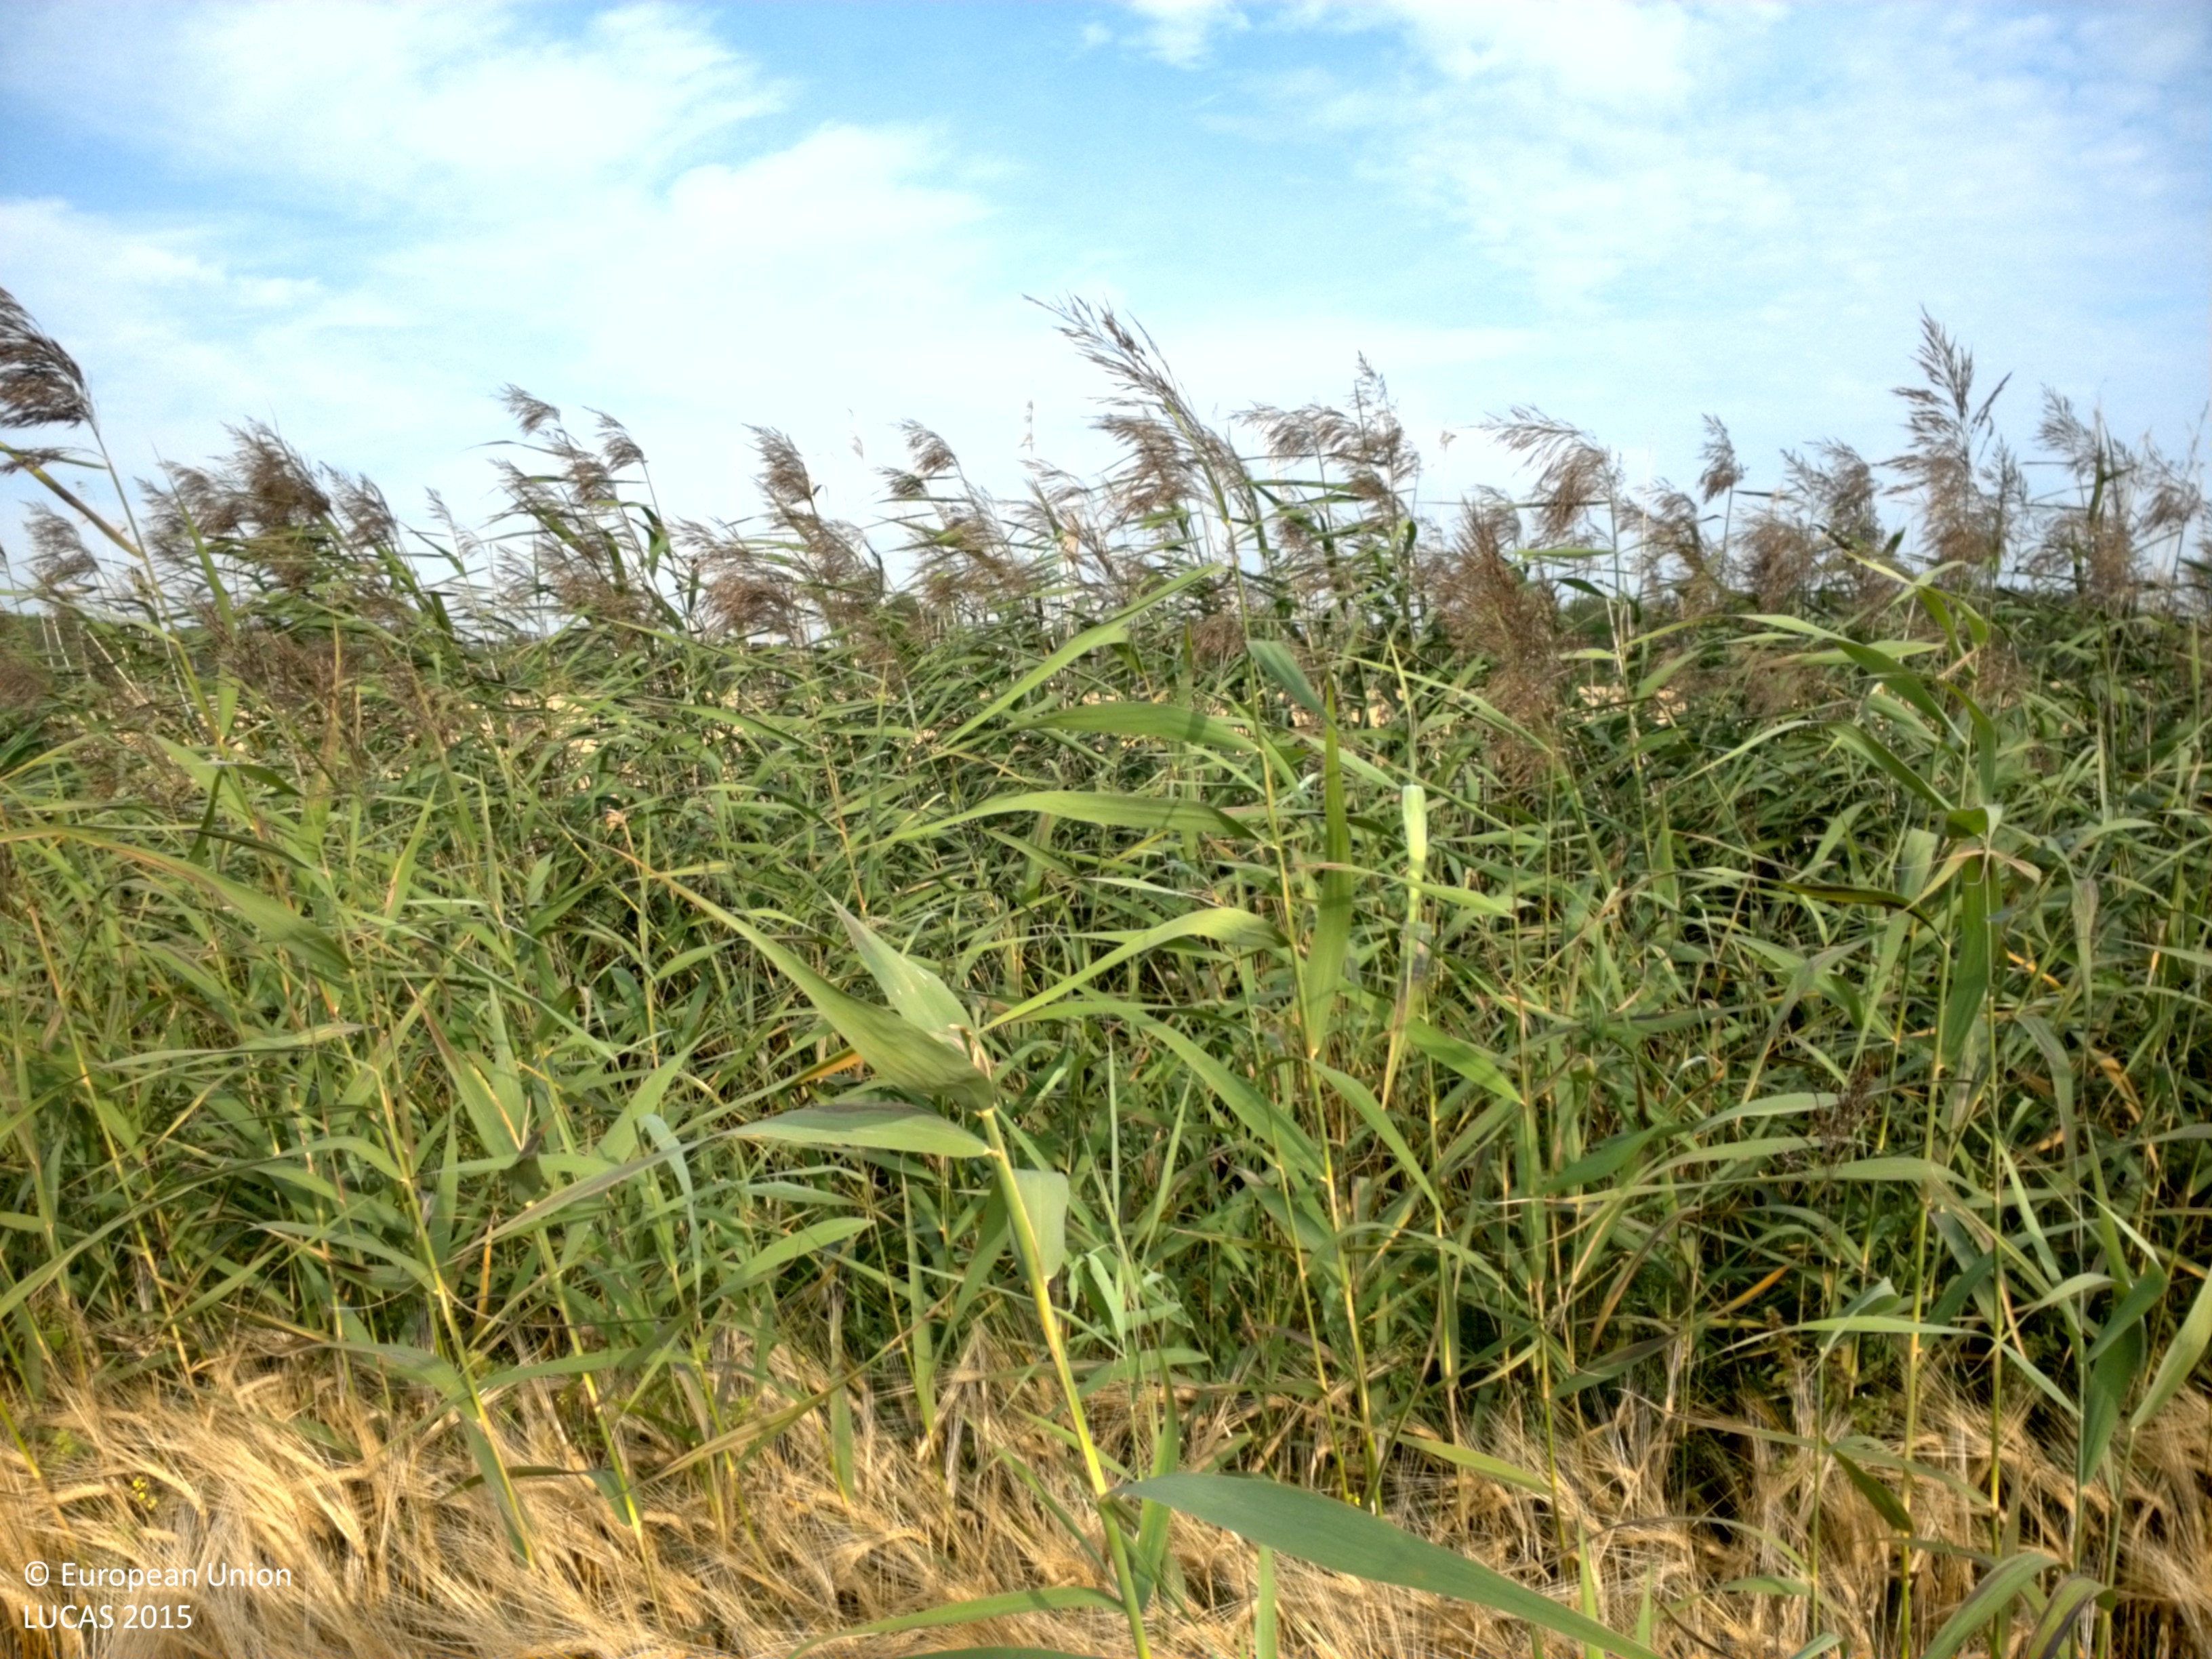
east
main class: Cropland
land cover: Barley
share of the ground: > 75 %
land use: Agriculture (excluding fallow land and kitchen gardens)
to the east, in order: Barley; Grass margins; Ditches and canals; Barley
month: August
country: SE
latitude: 60.0486
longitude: 17.5889
